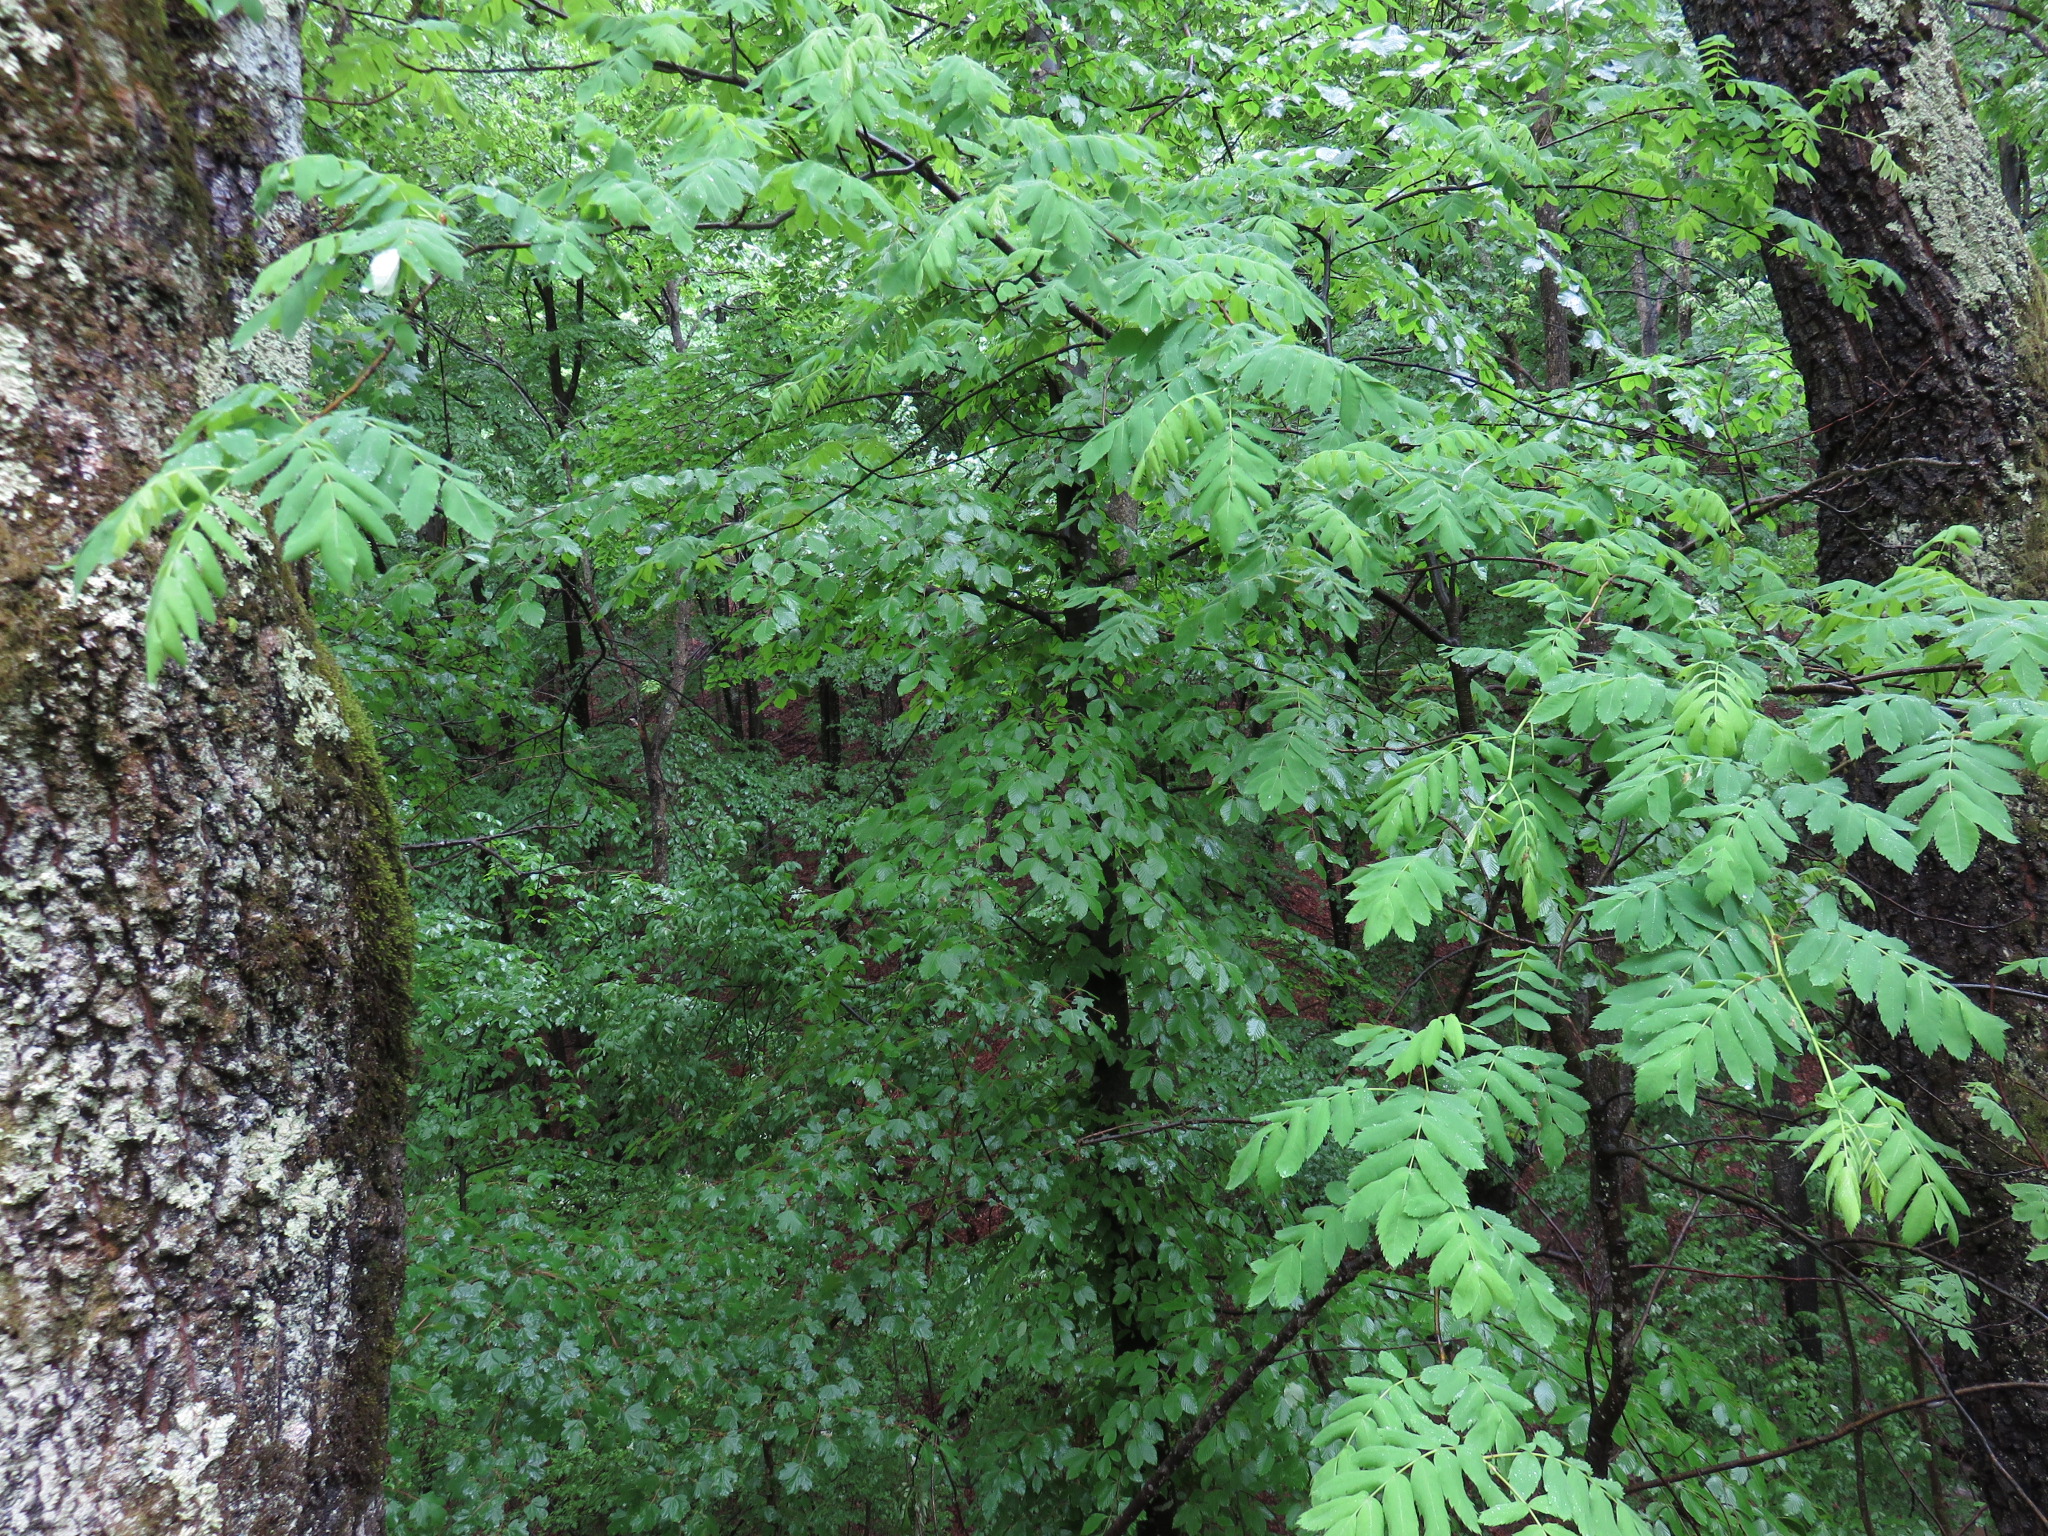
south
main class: Woodland
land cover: Broadleaved woodland
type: mesophytic deciduous forest
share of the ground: > 75 %
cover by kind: broadleaved forest trees 95 %, shrubs 5 %
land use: Forestry
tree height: < 5 m
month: May
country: BG
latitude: 42.9340
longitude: 24.8024
